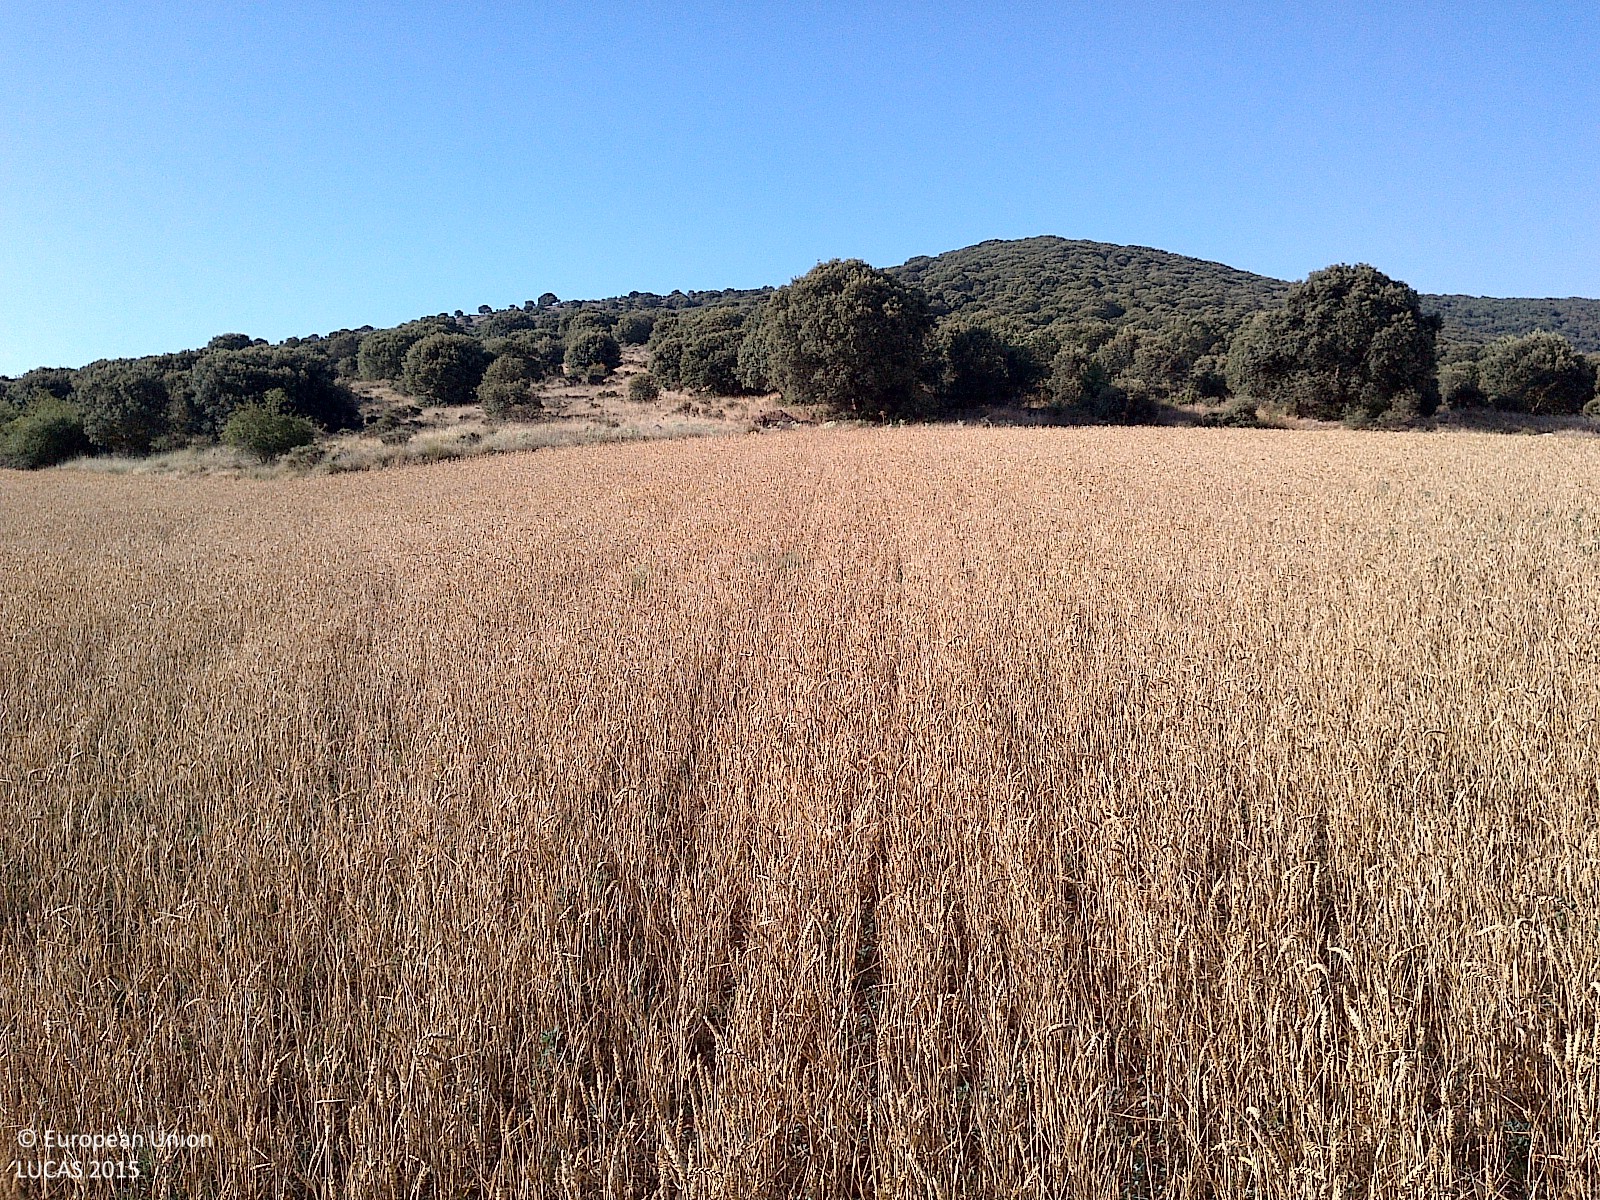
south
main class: Cropland
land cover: Common wheat
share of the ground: 50 - 75 %
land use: Agriculture (excluding fallow land and kitchen gardens)
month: July
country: ES
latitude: 41.8268
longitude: -2.0136
